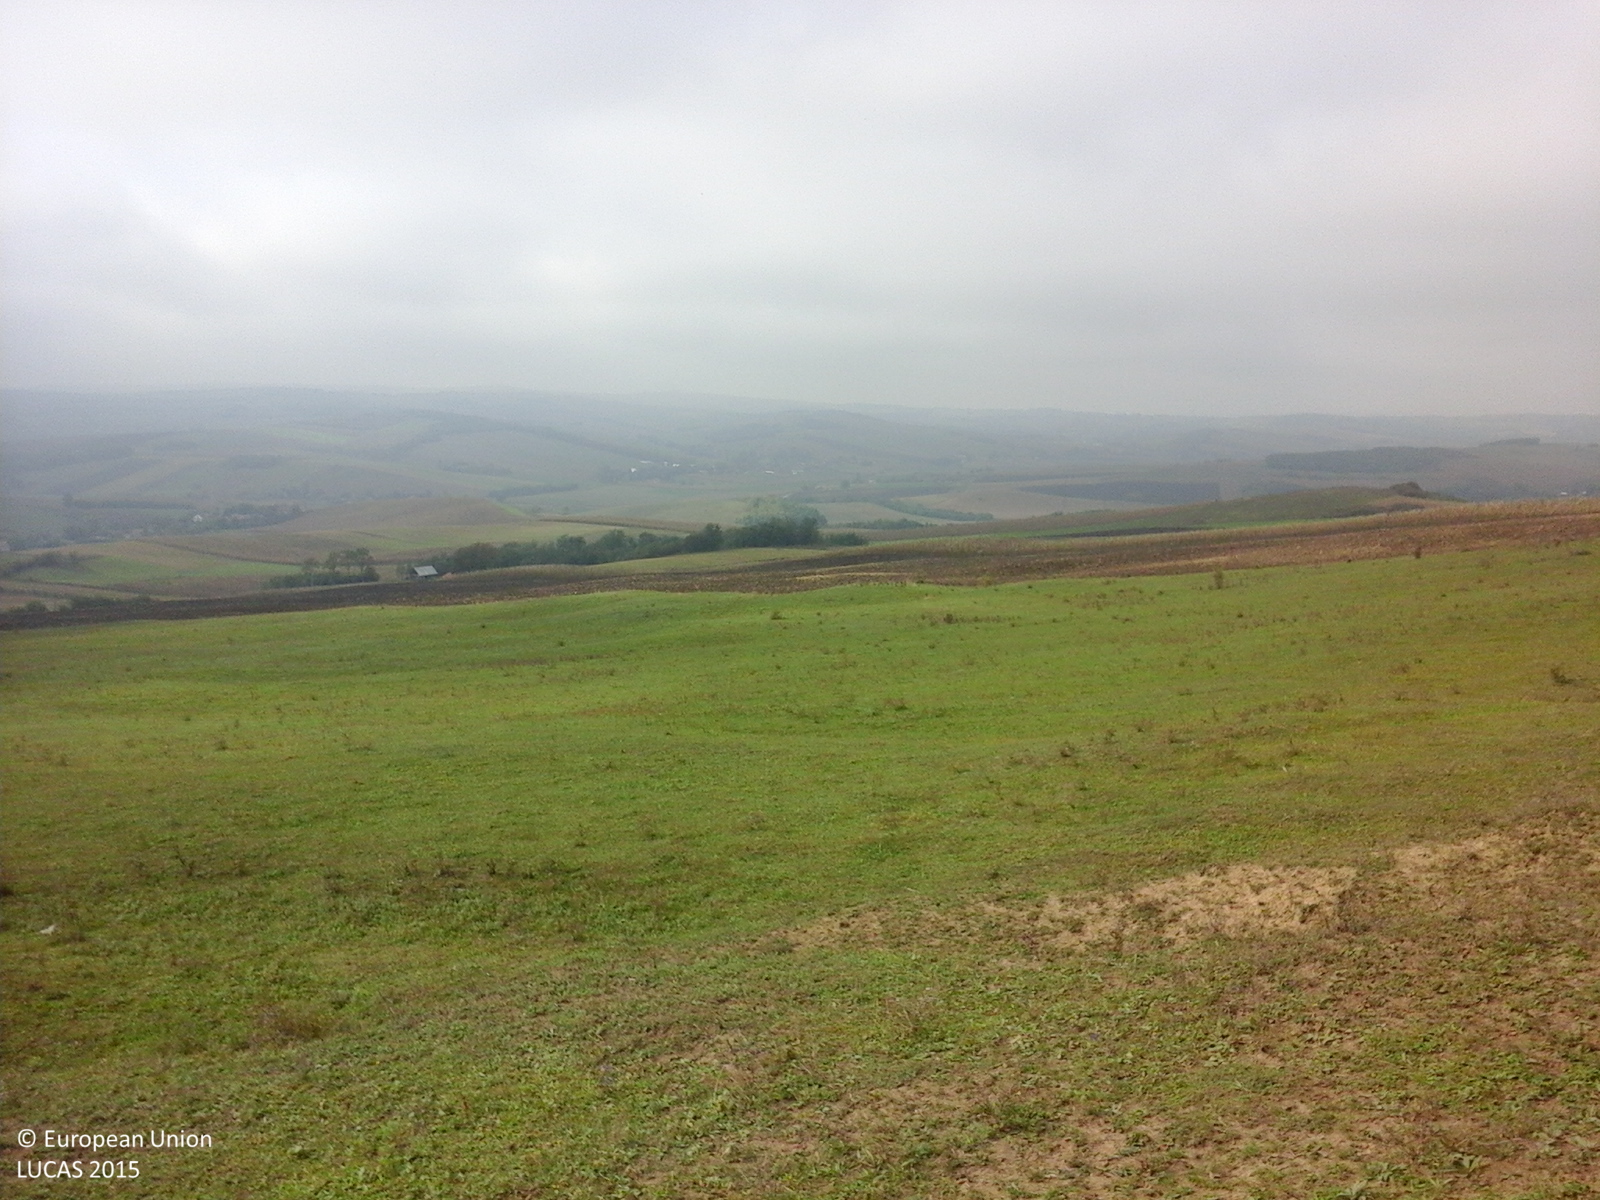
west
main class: Grassland
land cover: Grassland without tree/shrub cover
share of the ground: > 75 %
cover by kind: herbaceous plants 100 %
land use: Agriculture (excluding fallow land and kitchen gardens)
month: October
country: RO
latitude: 46.6371
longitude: 24.3629
